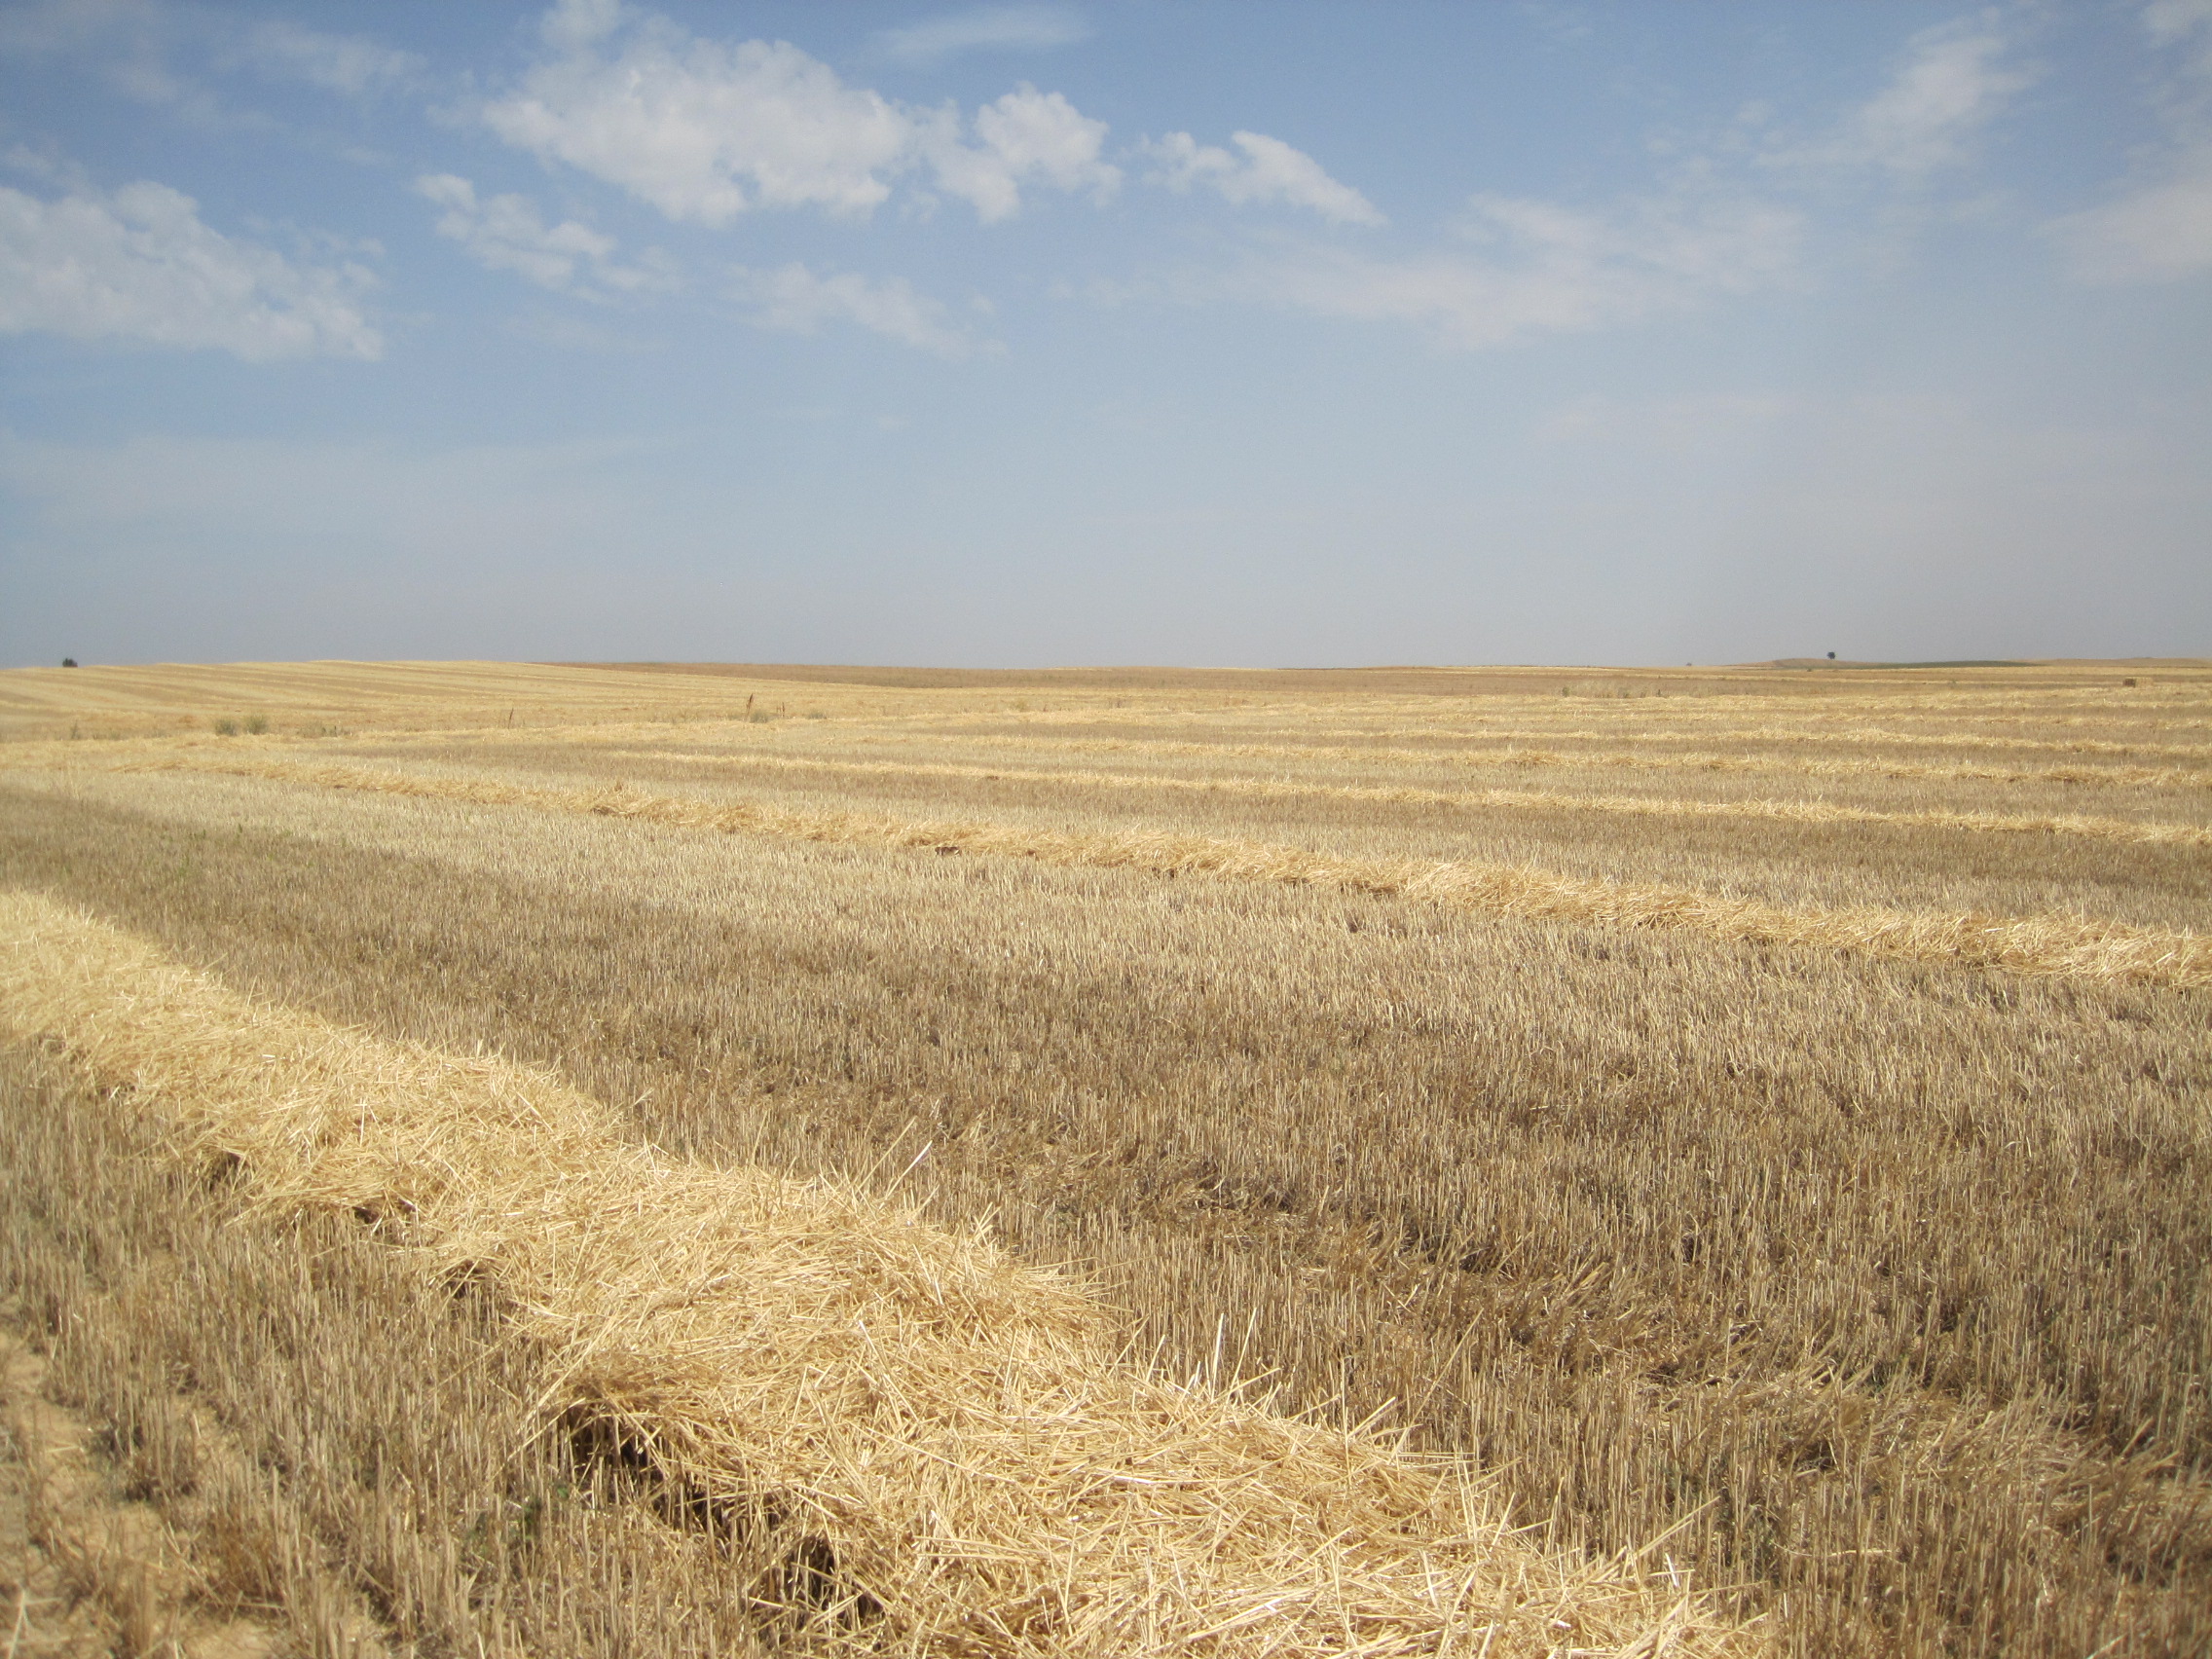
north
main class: Cropland
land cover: Common wheat
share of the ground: < 10 %
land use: Agriculture (excluding fallow land and kitchen gardens)
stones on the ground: 10 - 25 %
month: July
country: ES
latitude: 41.7683
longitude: -5.5927
